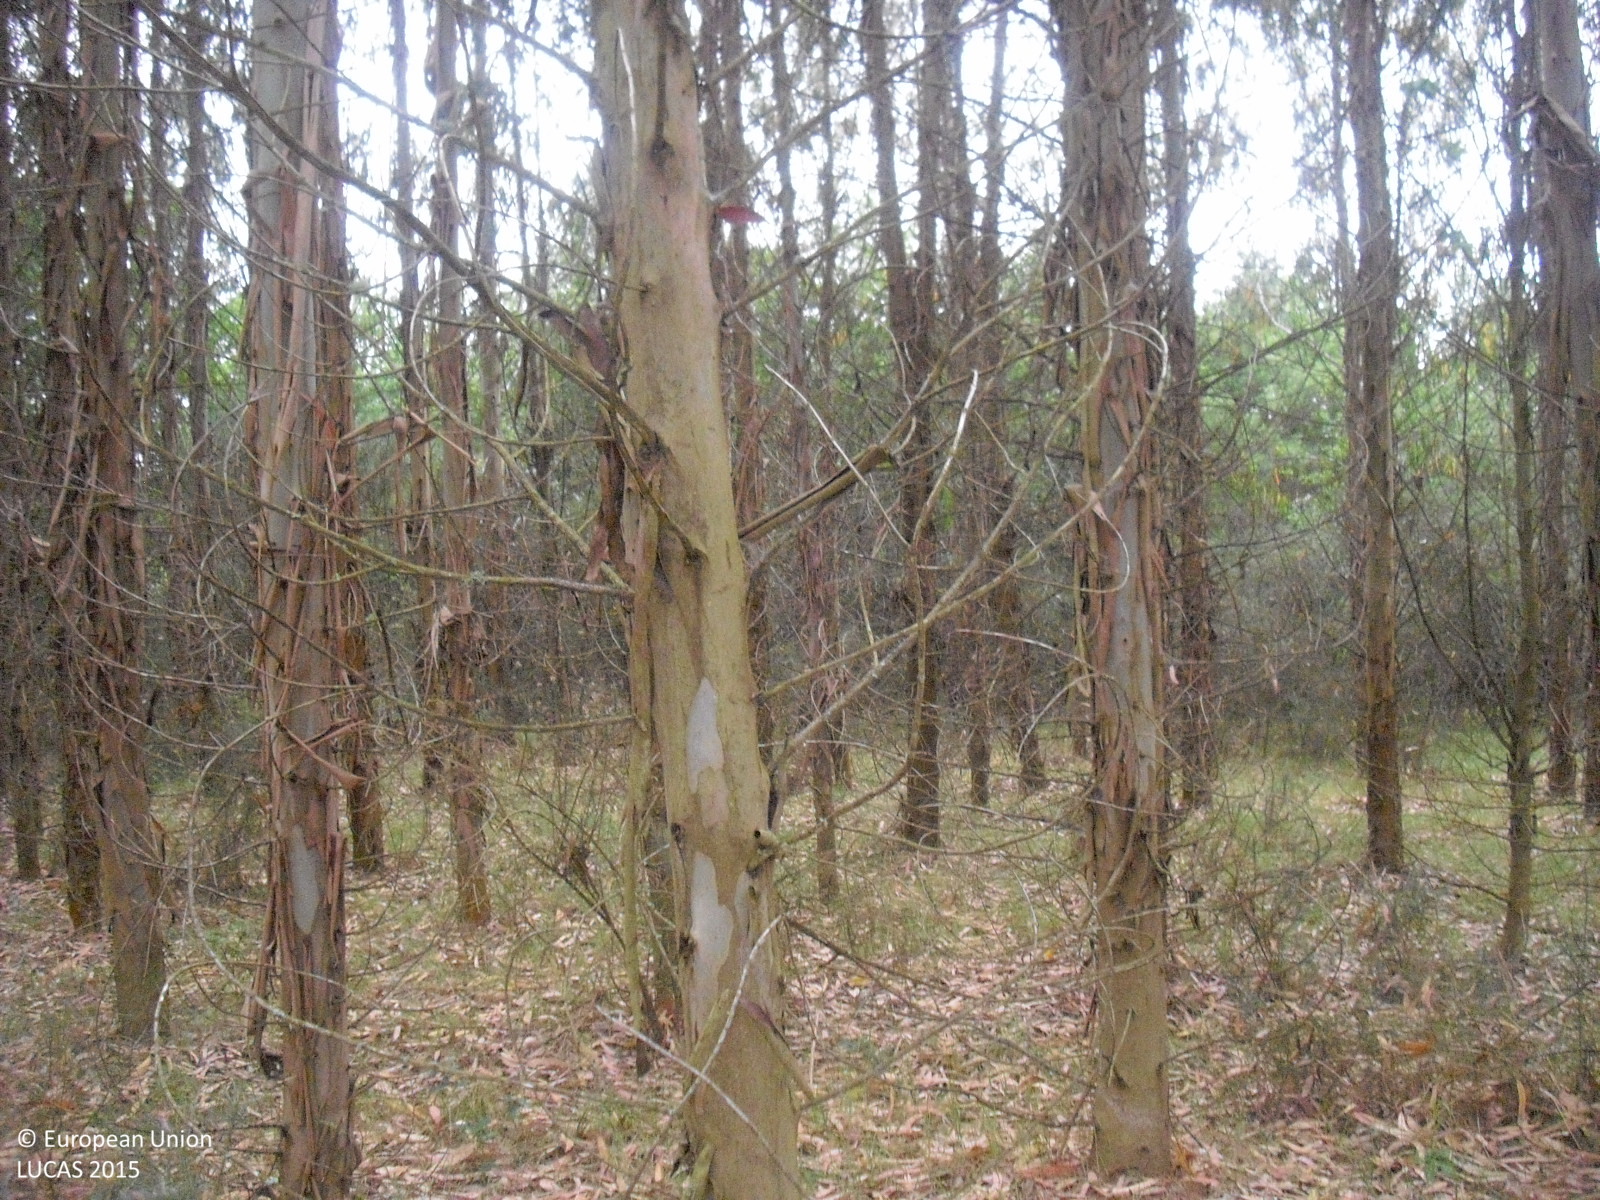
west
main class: Woodland
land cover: Broadleaved woodland
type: exotic forest
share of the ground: > 75 %
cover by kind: broadleaved forest trees 100 %
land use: Forestry
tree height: > 5 m
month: June
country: ES
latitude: 42.7665
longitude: -7.8637
